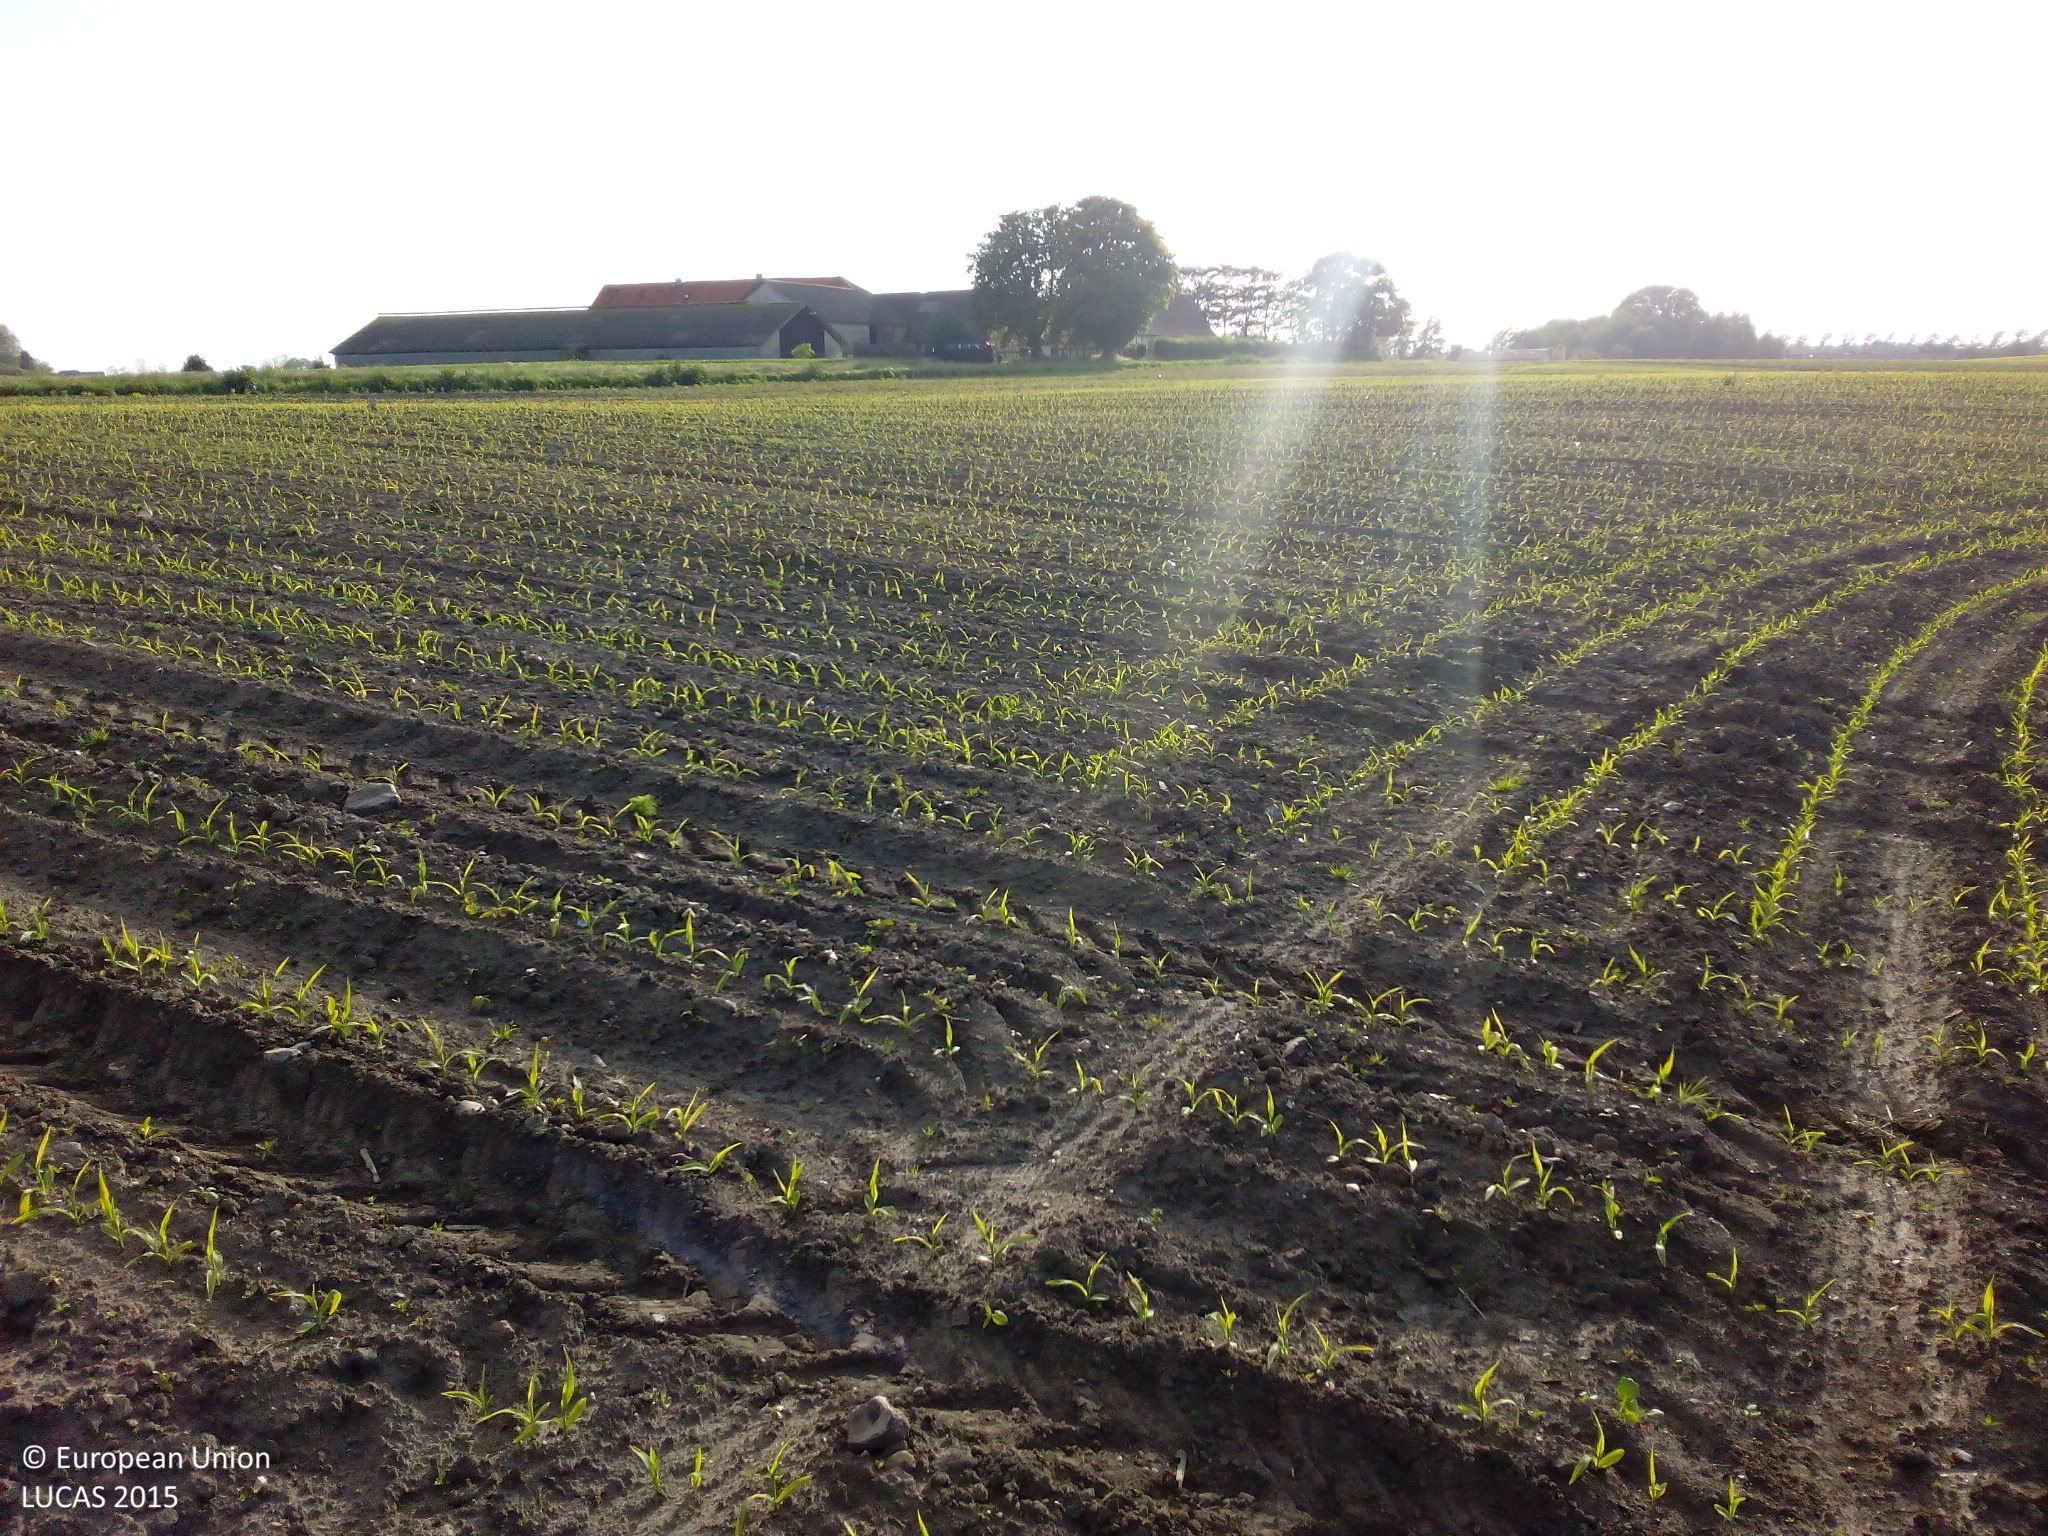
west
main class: Cropland
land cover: Maize
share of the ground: < 10 %
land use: Agriculture (excluding fallow land and kitchen gardens)
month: June
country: DK
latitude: 55.5210
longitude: 10.6488
